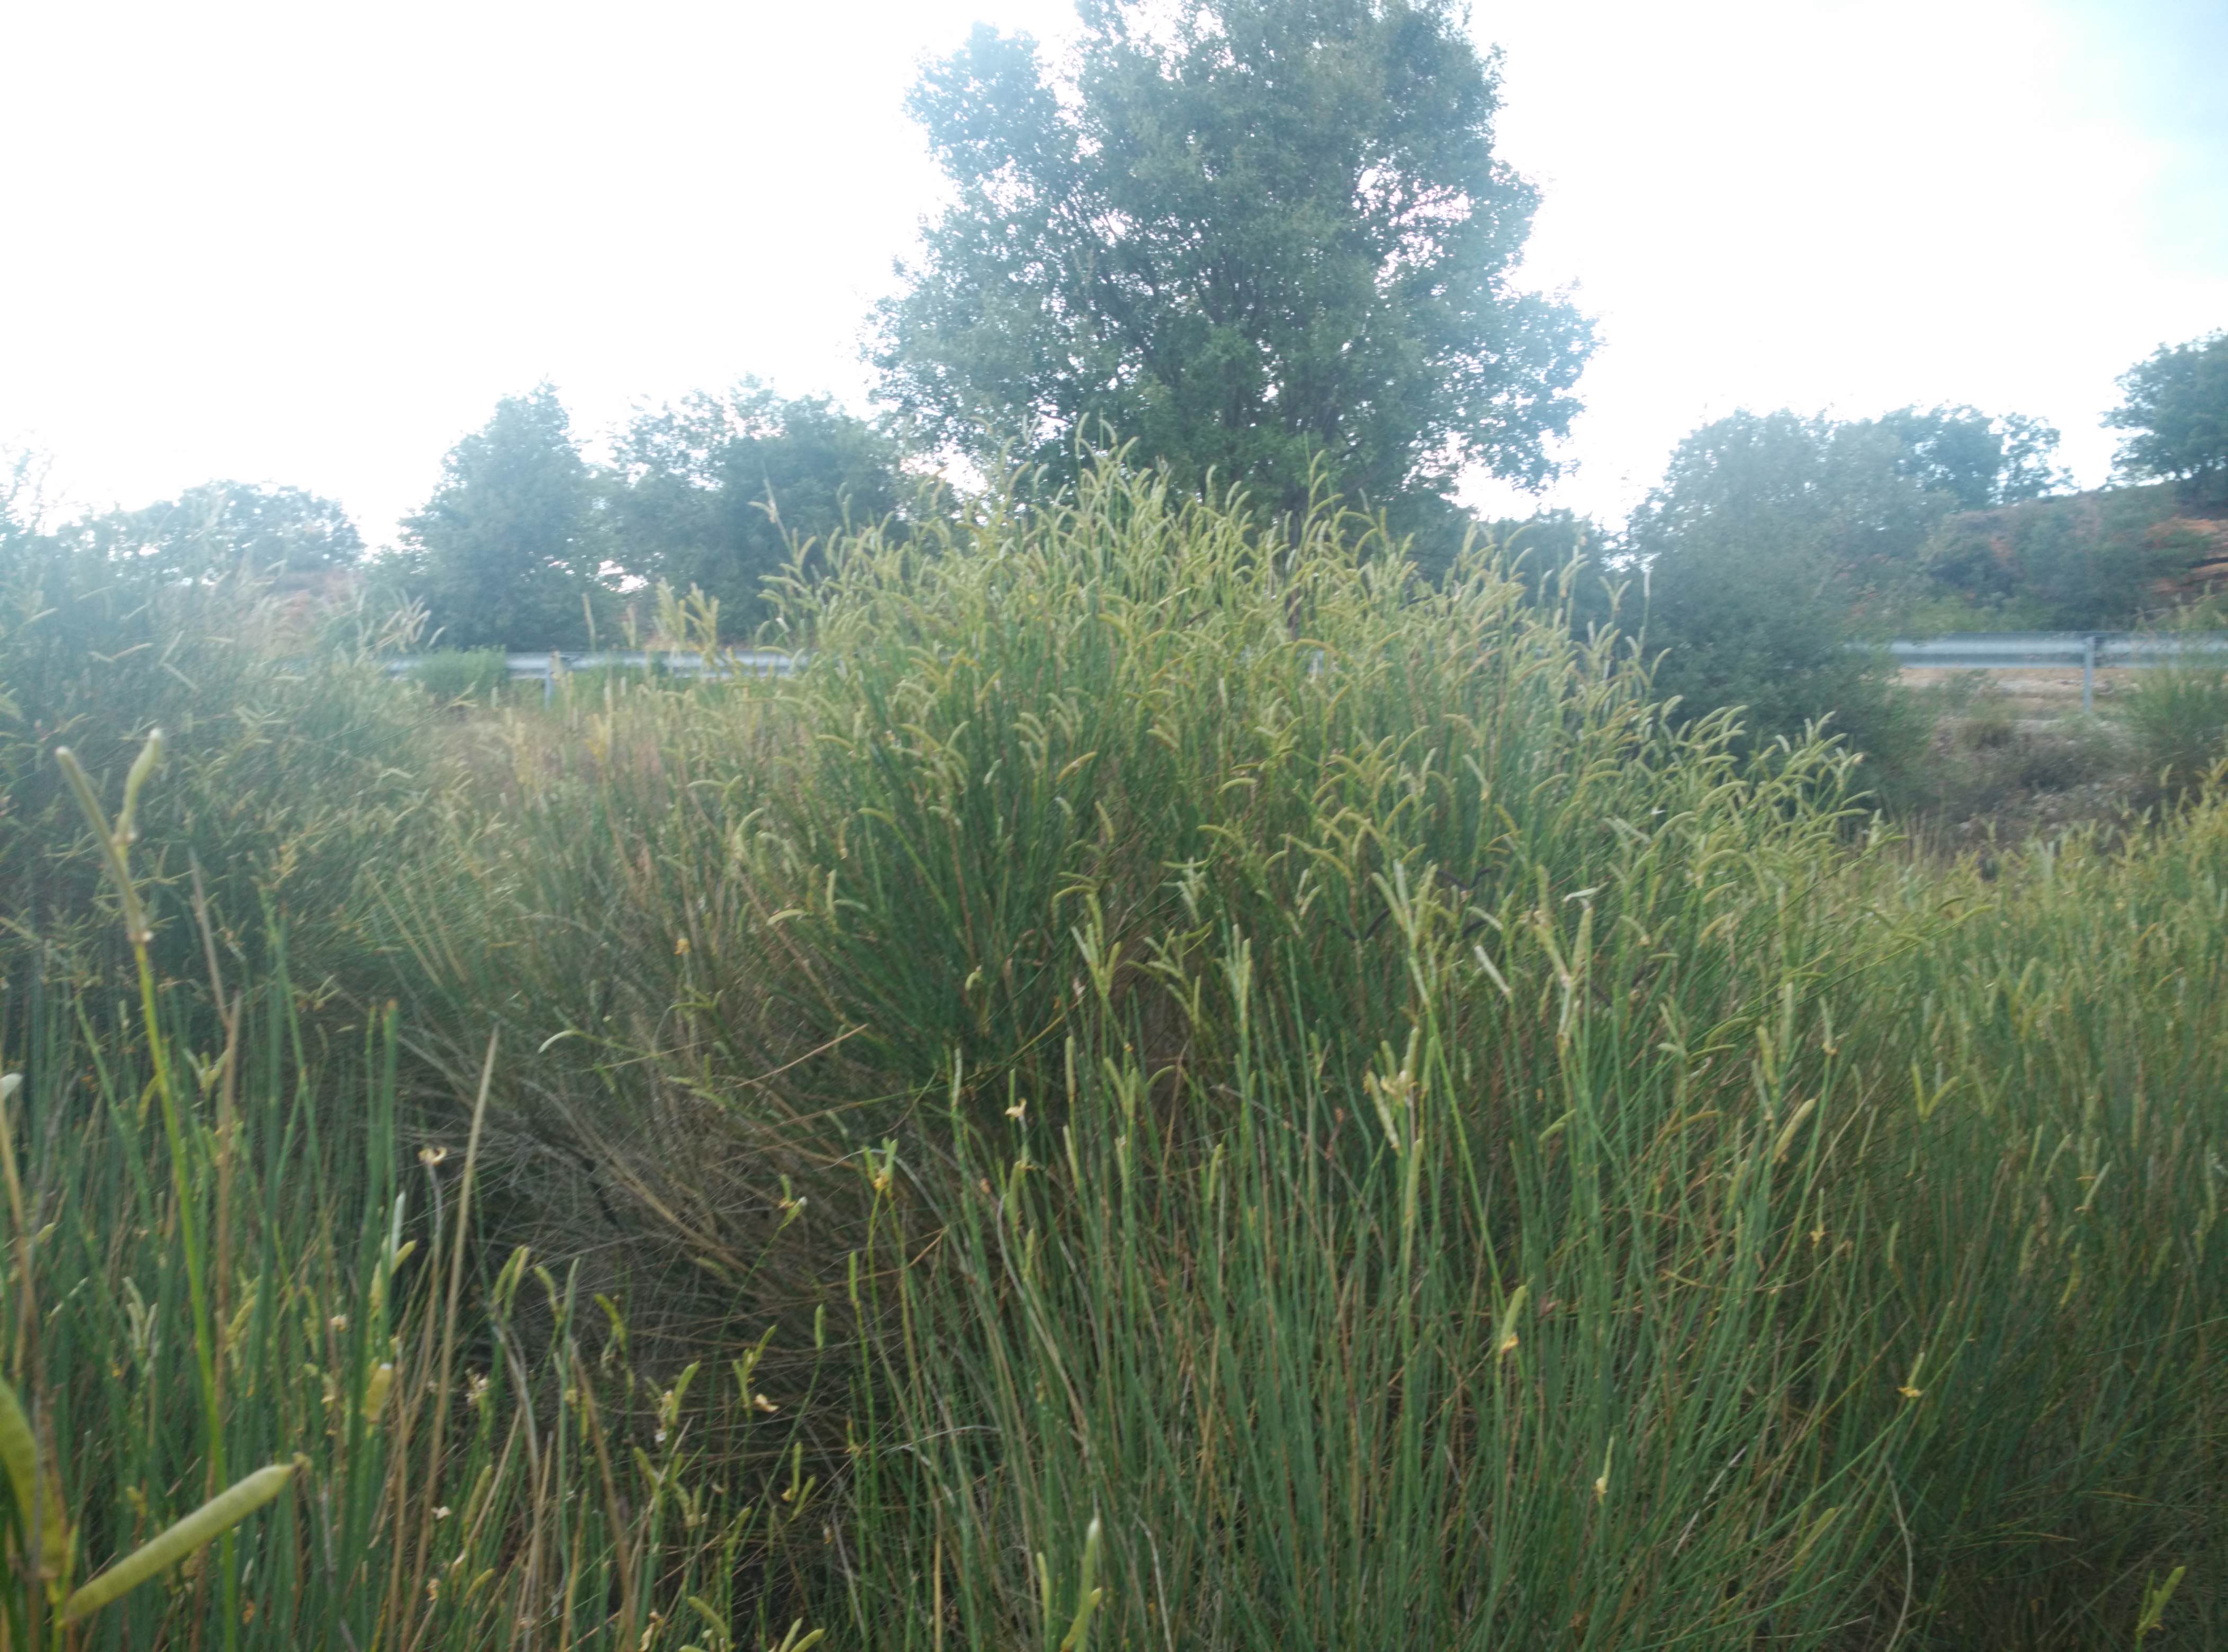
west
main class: Shrubland
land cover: Shrubland without tree cover
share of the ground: 50 - 75 %
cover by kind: shrubs 70 %, unconsolidated bare surface 30 %
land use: Semi-natural and natural areas not in use
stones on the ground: > 50 %
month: July
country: ES
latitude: 40.9639
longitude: -2.6380
